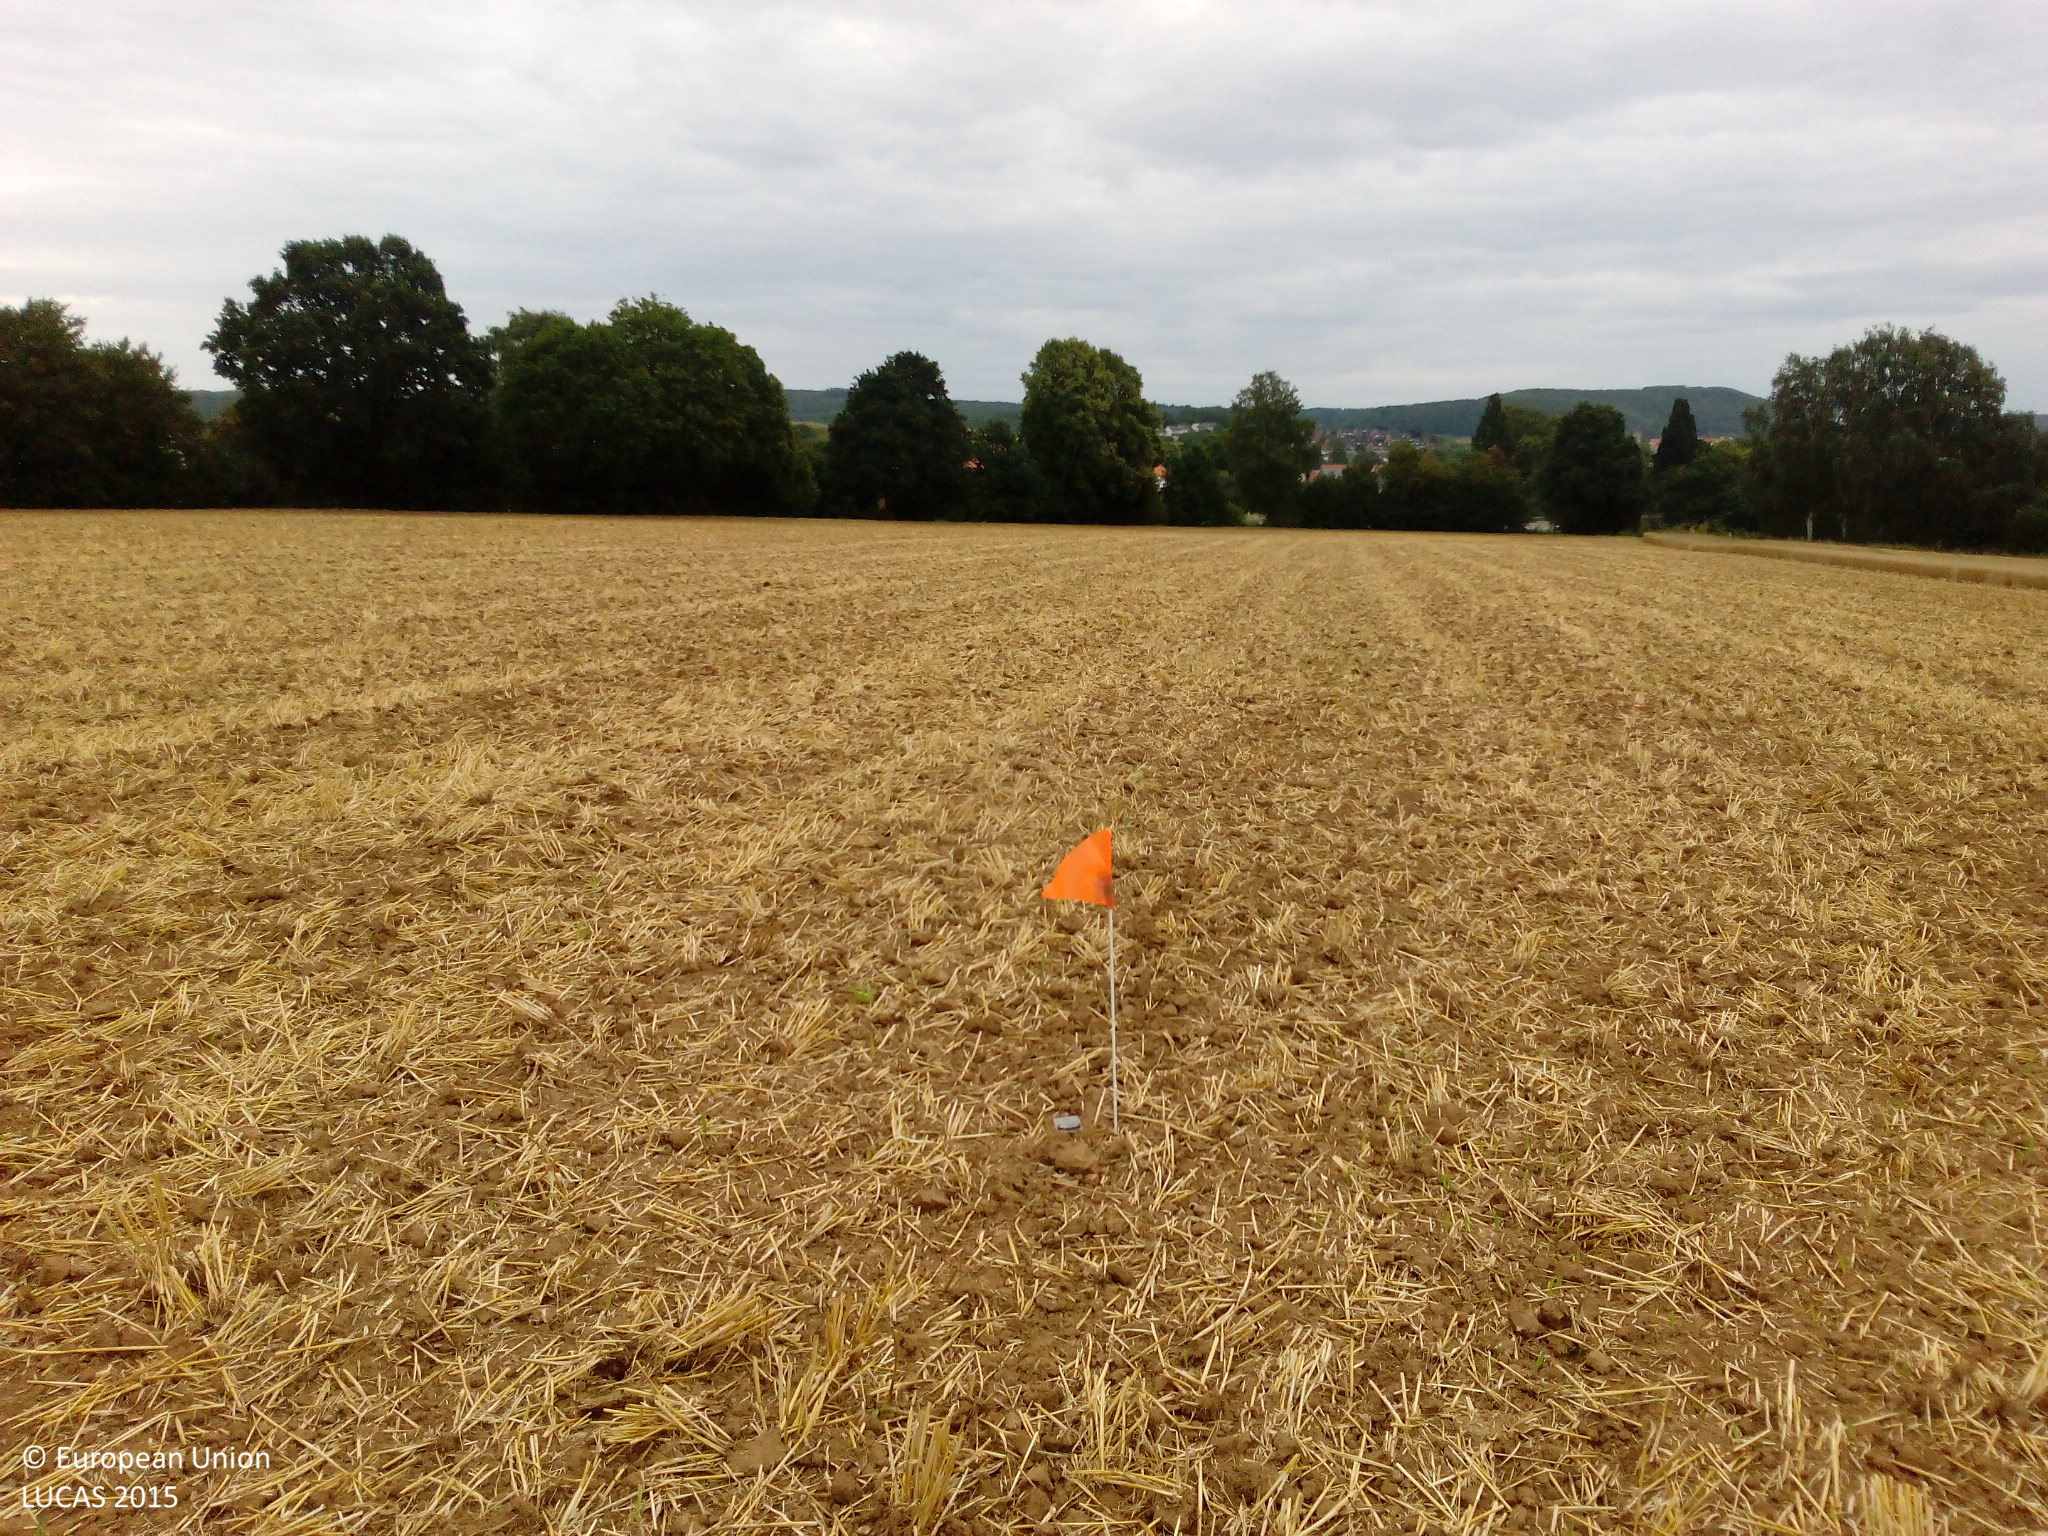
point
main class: Cropland
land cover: Barley
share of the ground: < 10 %
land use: Agriculture (excluding fallow land and kitchen gardens)
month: July
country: DE
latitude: 51.4406
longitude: 9.2953
